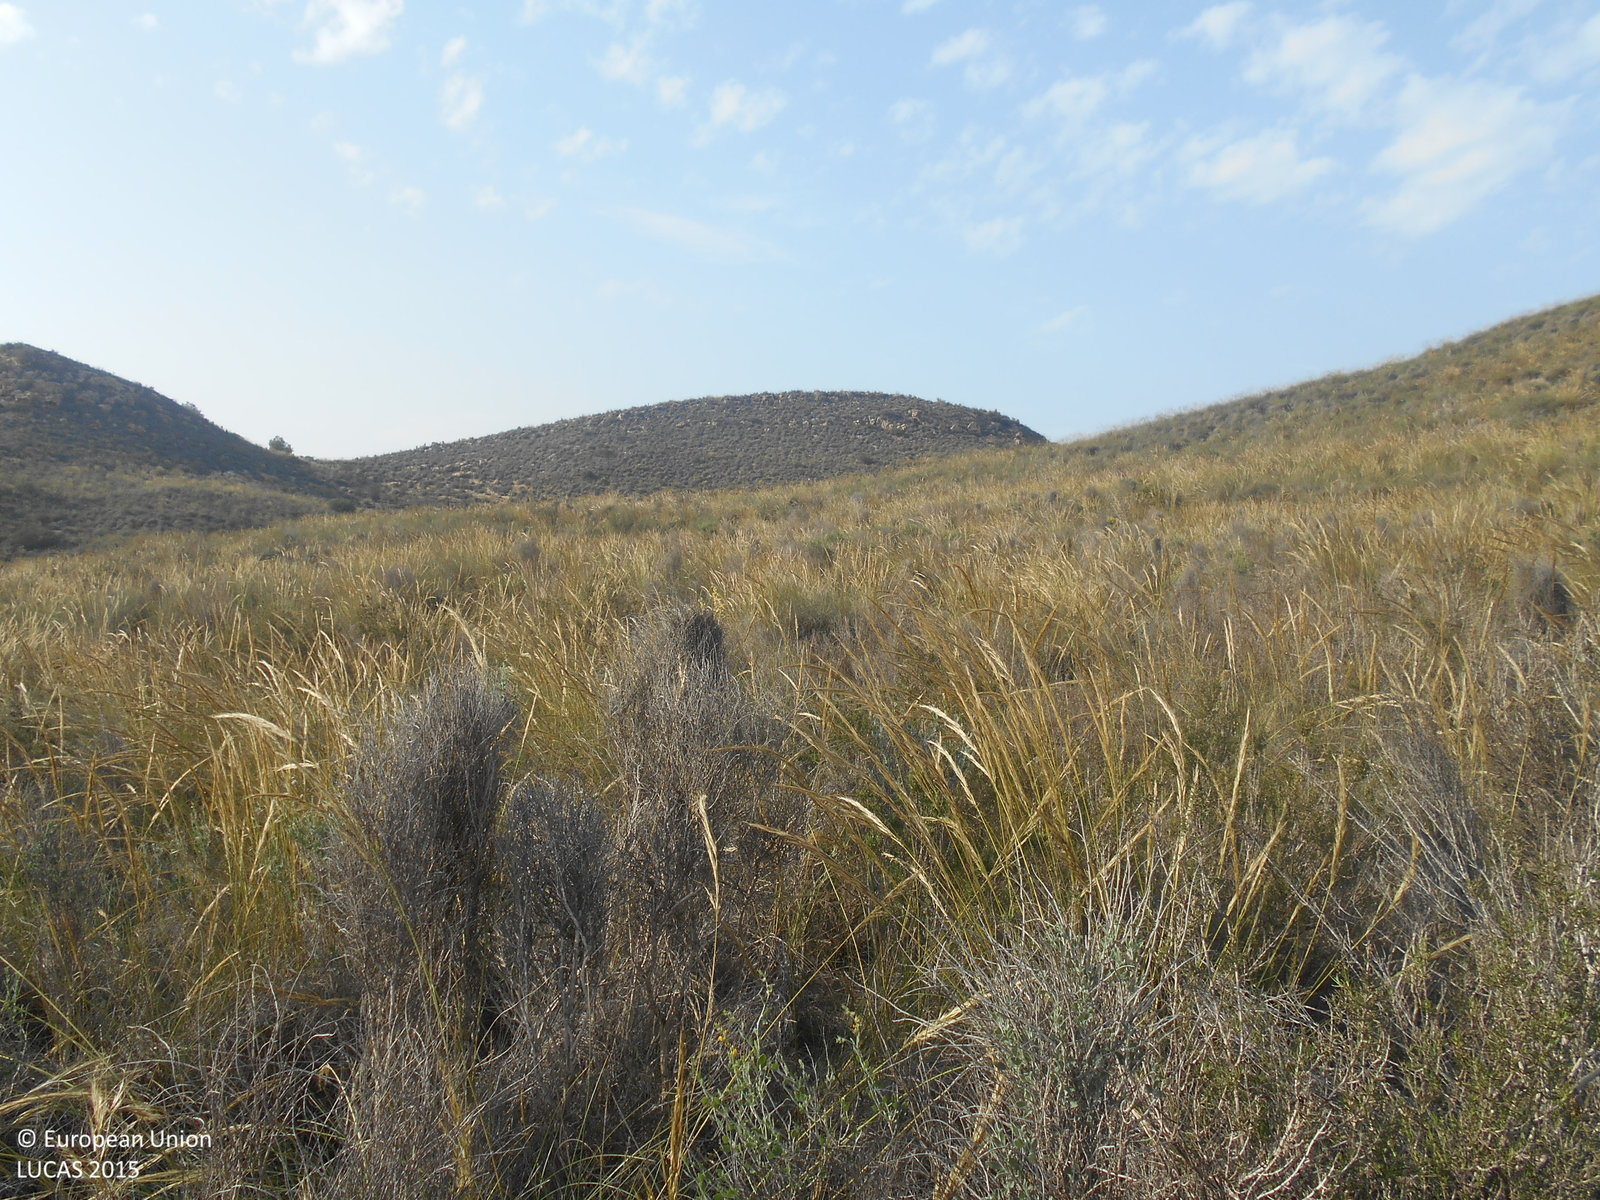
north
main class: Shrubland
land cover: Shrubland without tree cover
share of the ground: > 75 %
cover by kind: shrubs 95 %, unconsolidated bare surface 5 %
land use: Semi-natural and natural areas not in use
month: April
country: ES
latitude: 37.6746
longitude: -1.3074
